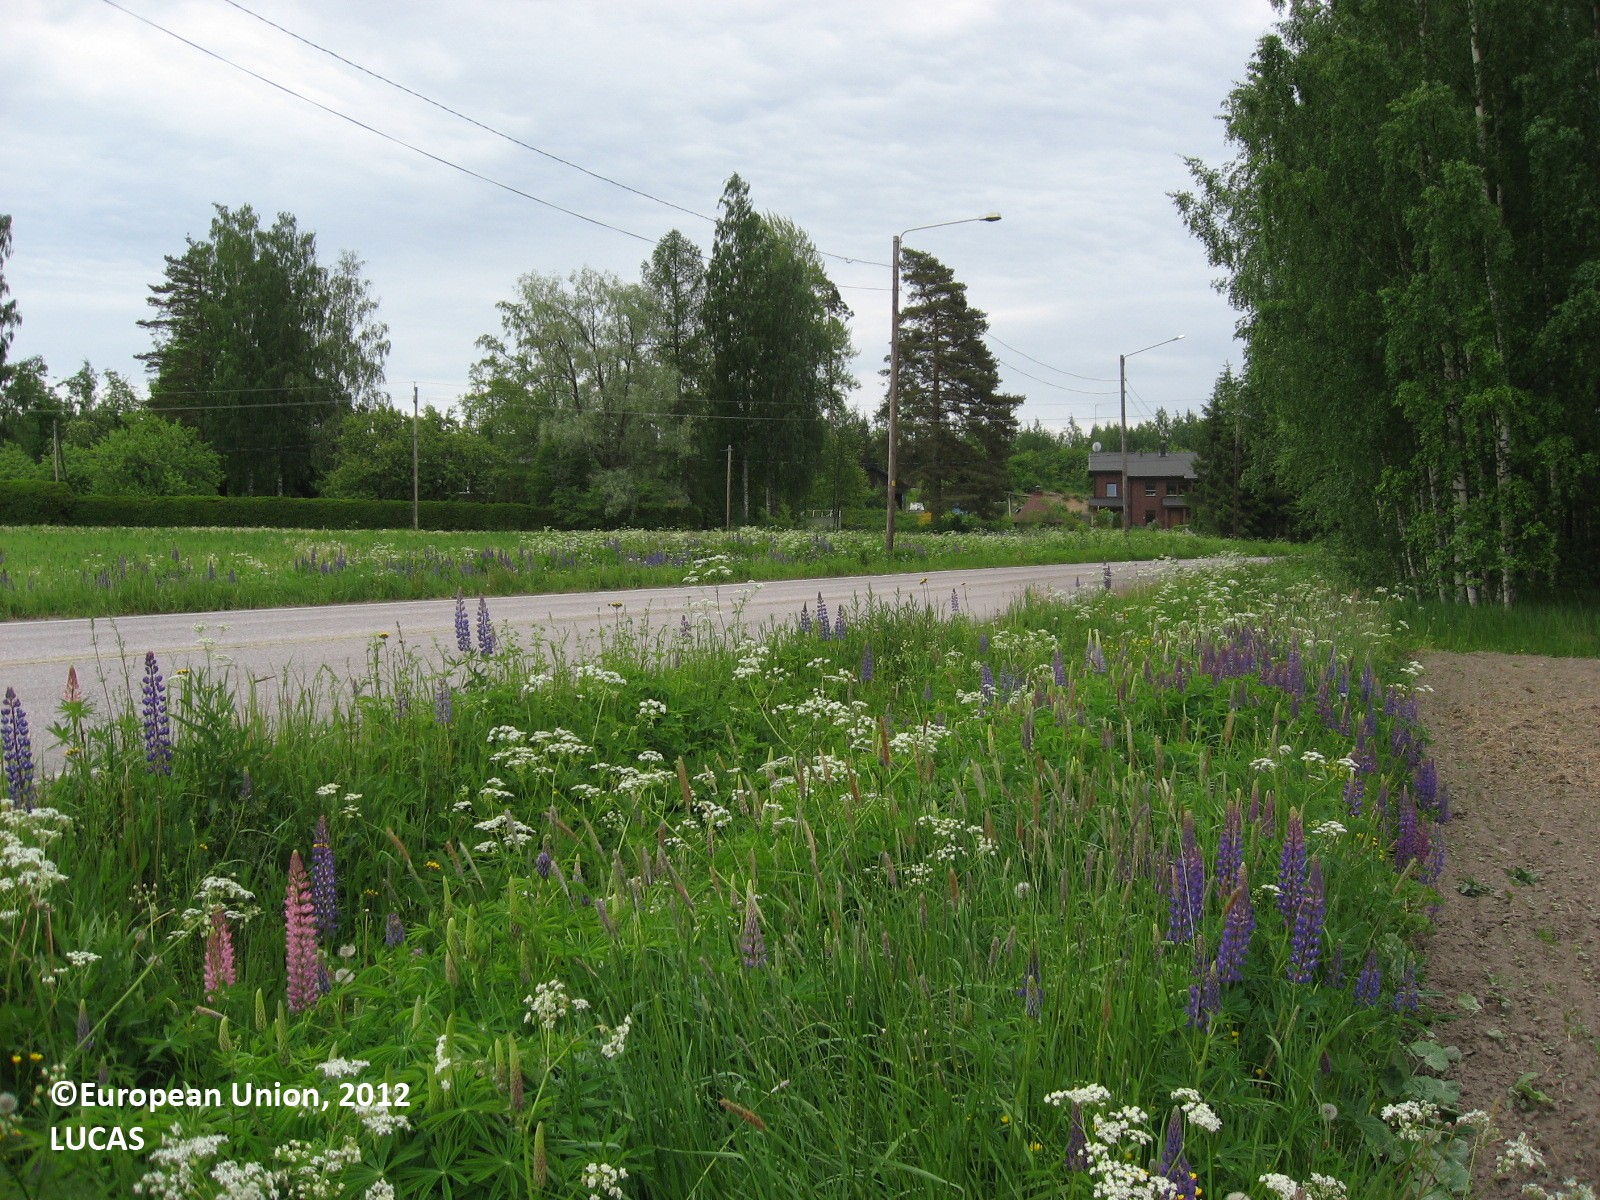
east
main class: Cropland
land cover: Other cereals
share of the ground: < 10 %
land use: Agriculture (excluding fallow land and kitchen gardens)
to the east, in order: Other cereals; Broadleaved woodland; Ditches and canals; Grass margins; Paved roads, cycling and walking lanes; Grass margins; Ditches and canals; Spontaneously vegetated surfaces; Electric lines; Ditches and canals; Spontaneously vegetated surfaces; Electric lines; Spontaneously vegetated surfaces; Artificial constructions in urban areas; Grassland with sparse tree/shrub cover; Paved roads, cycling and walking lanes; Pine dominated coniferous woodland; Spontaneously vegetated surfaces; Pine dominated mixed woodland
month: June
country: FI
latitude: 60.4202
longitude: 24.9916
